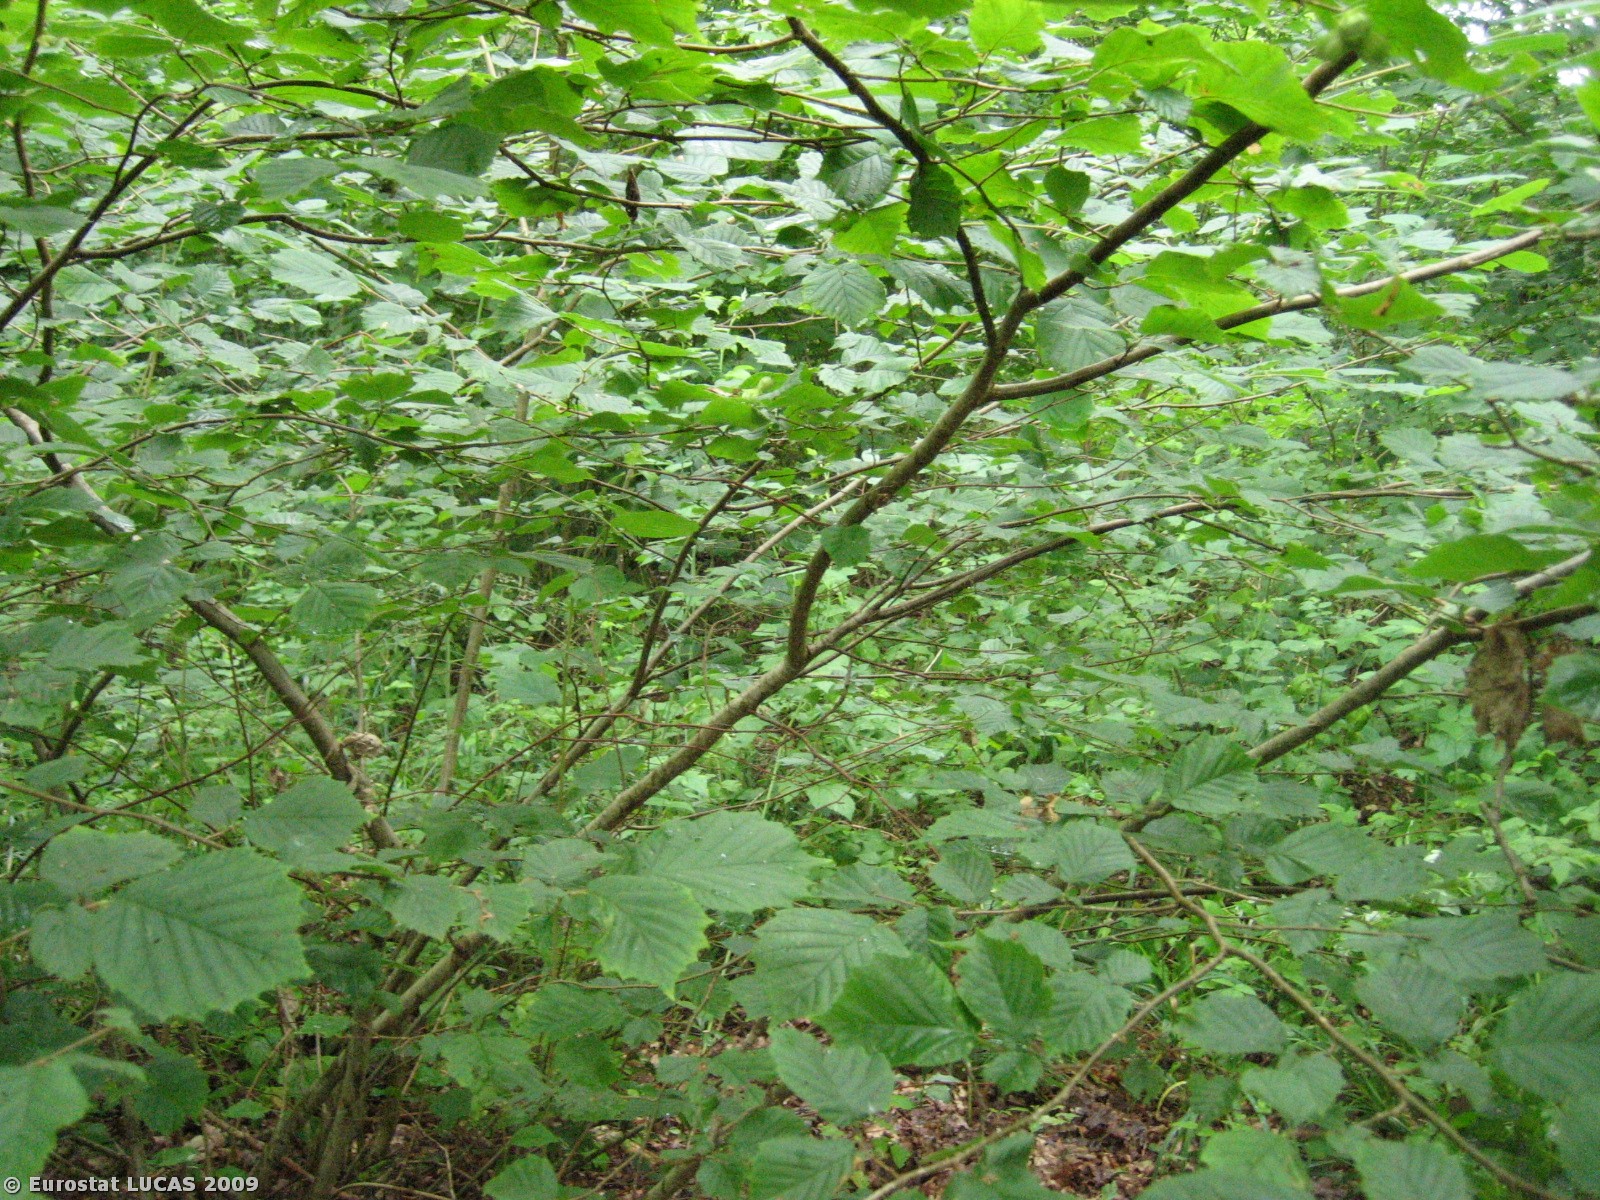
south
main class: Woodland
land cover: Broadleaved woodland
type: mesophytic deciduous forest
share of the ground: > 75 %
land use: Forestry
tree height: > 5 m
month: July
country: DK
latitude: 55.3609
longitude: 9.9212
